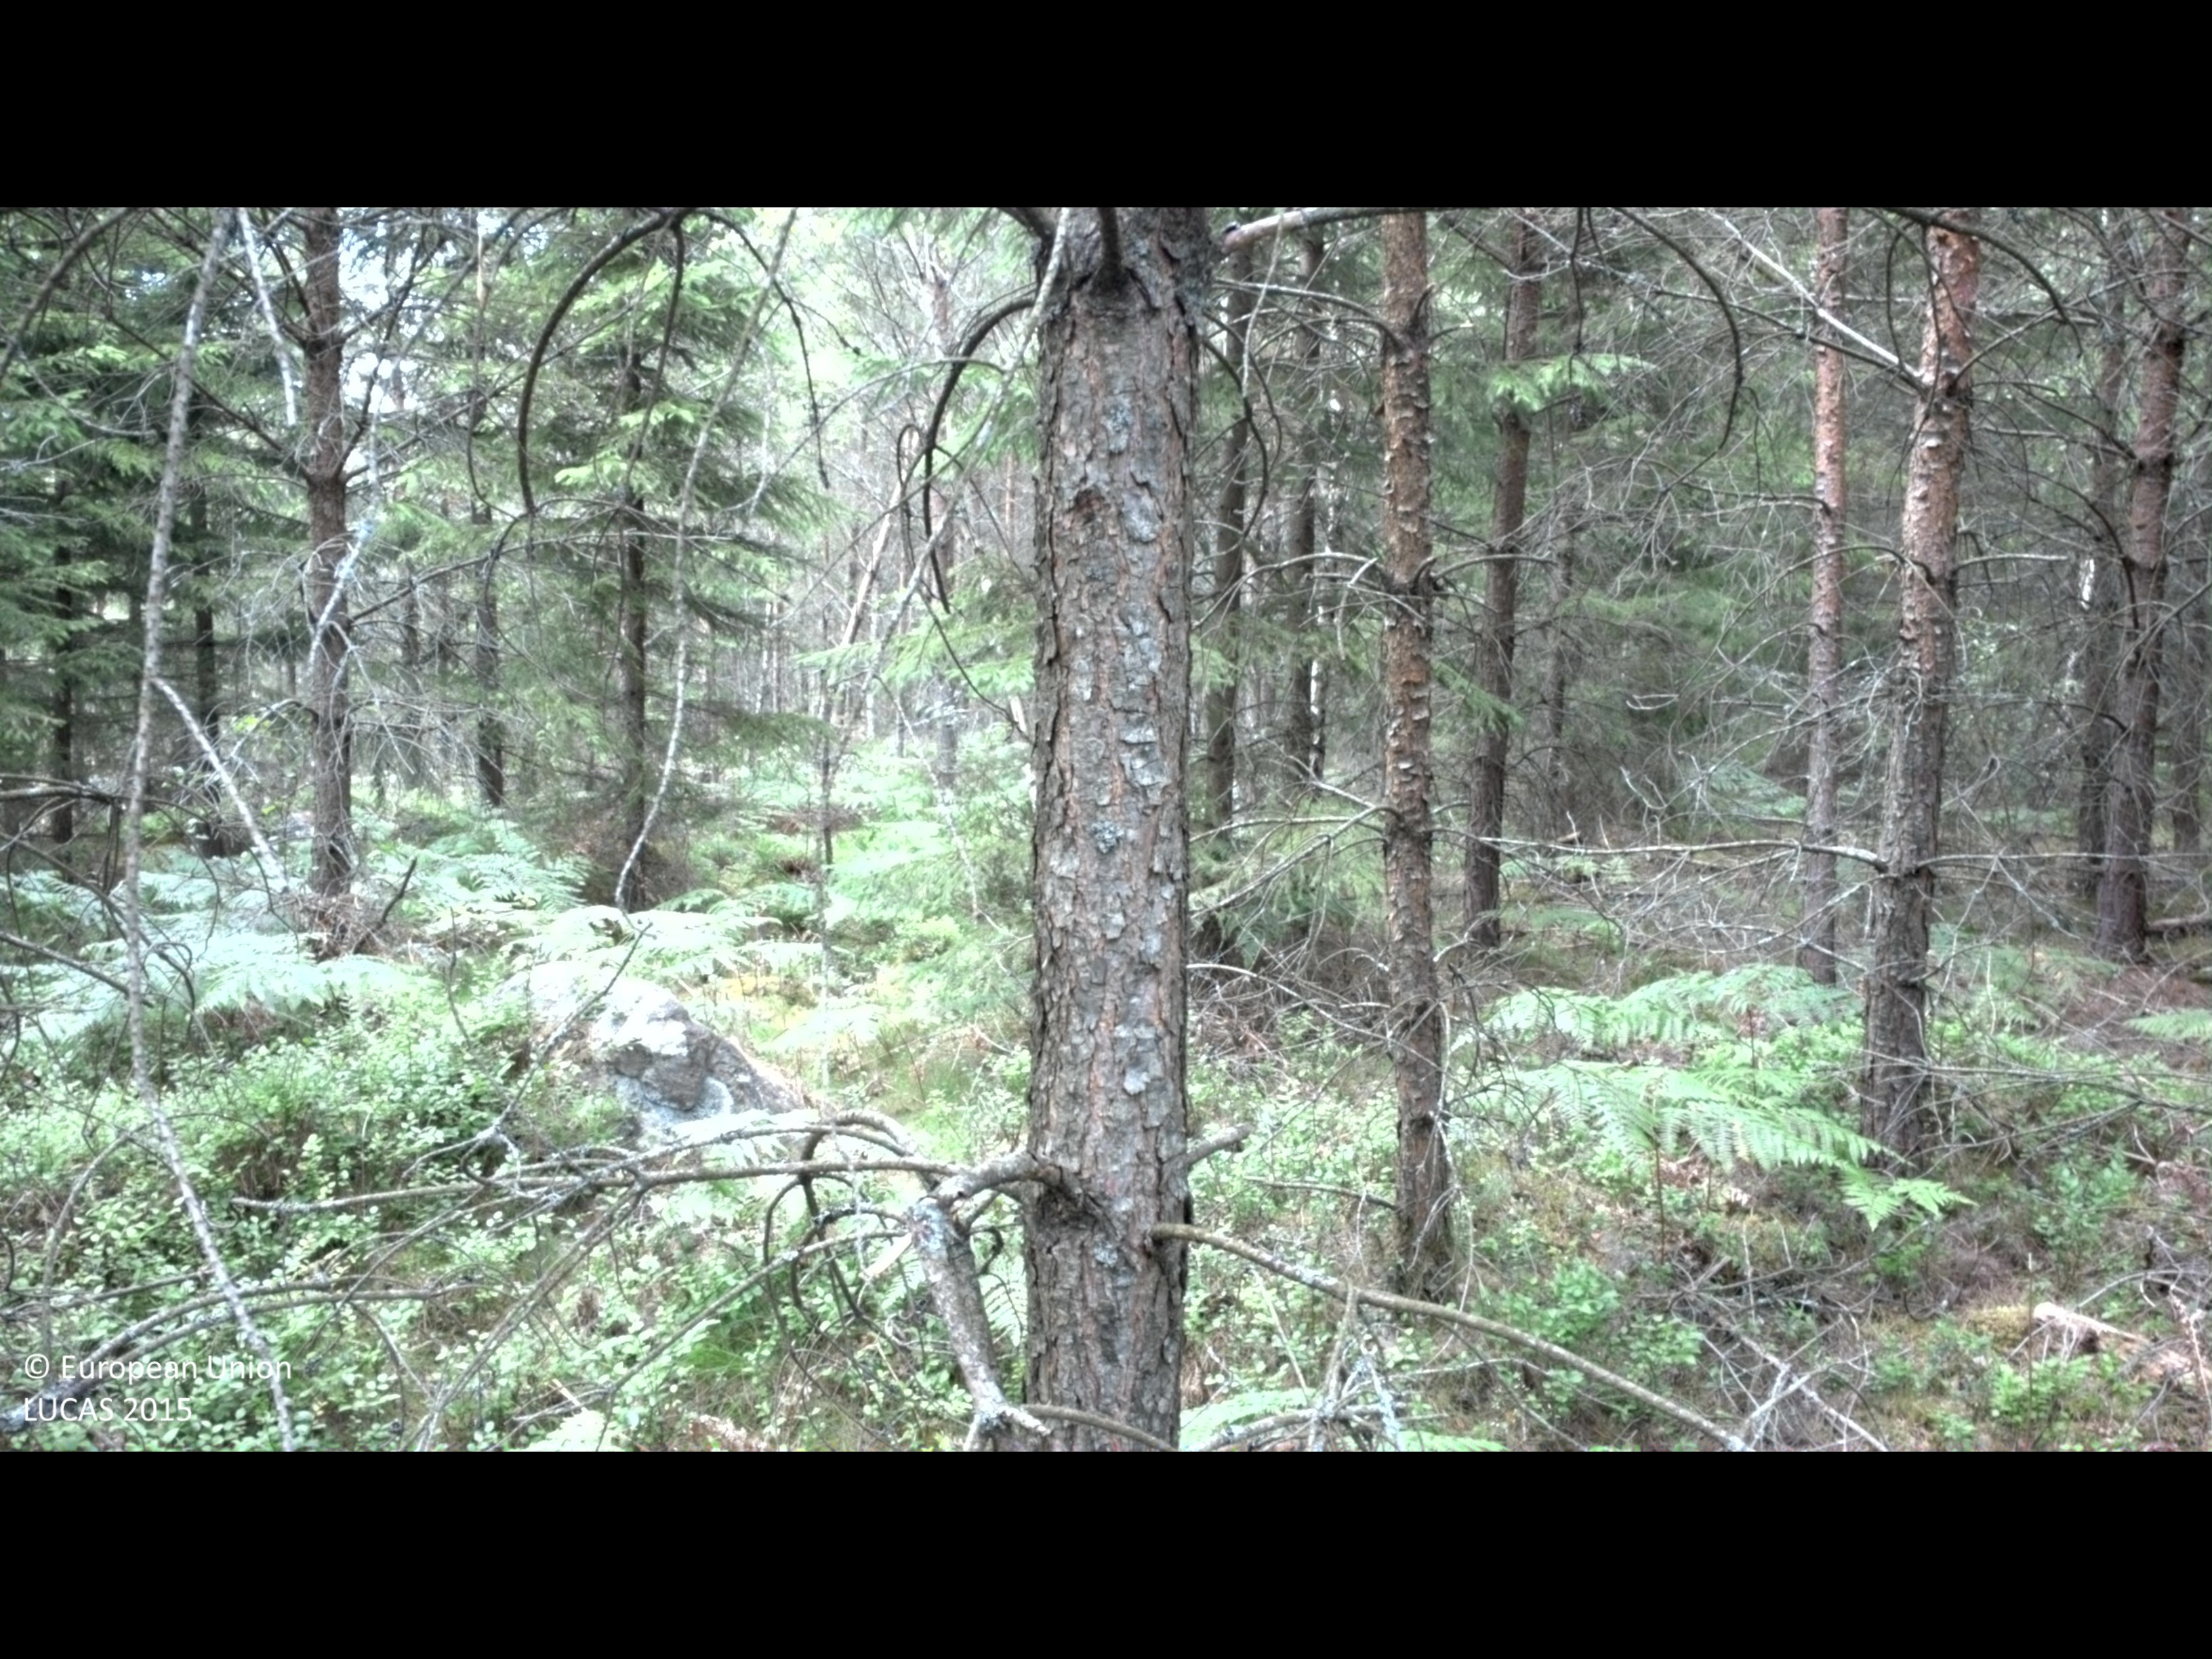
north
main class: Woodland
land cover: Other coniferous woodland
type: boreal forest
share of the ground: 50 - 75 %
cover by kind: coniferous forest trees 60 %, shrubs 25 %, broadleaved forest trees 10 %, herbaceous plants 5 %
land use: Forestry
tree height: > 5 m
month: July
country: SE
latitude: 56.4872
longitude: 14.4960
